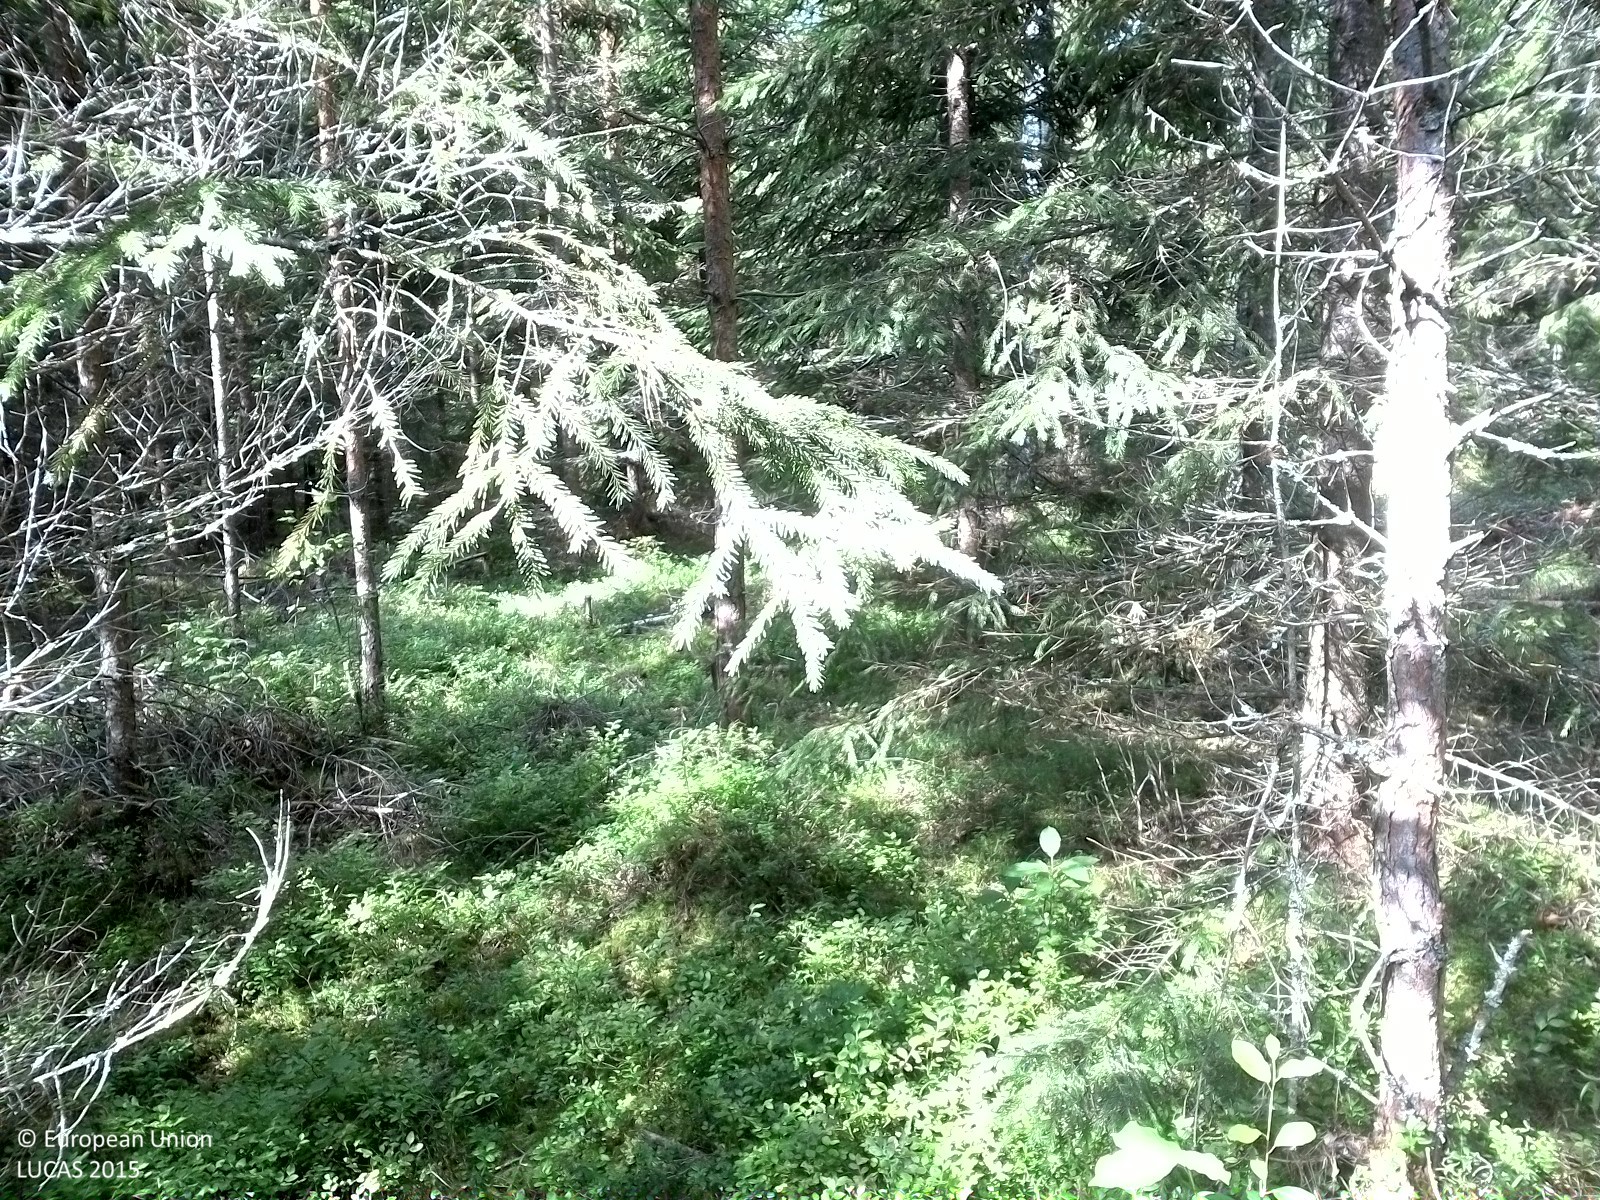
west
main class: Woodland
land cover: Other coniferous woodland
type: boreal forest
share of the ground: 50 - 75 %
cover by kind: coniferous forest trees 60 %, herbaceous plants 30 %, broadleaved forest trees 5 %, lichens and mosses 5 %
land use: Forestry
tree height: < 5 m
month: August
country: SE
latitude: 59.1474
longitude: 15.1842
